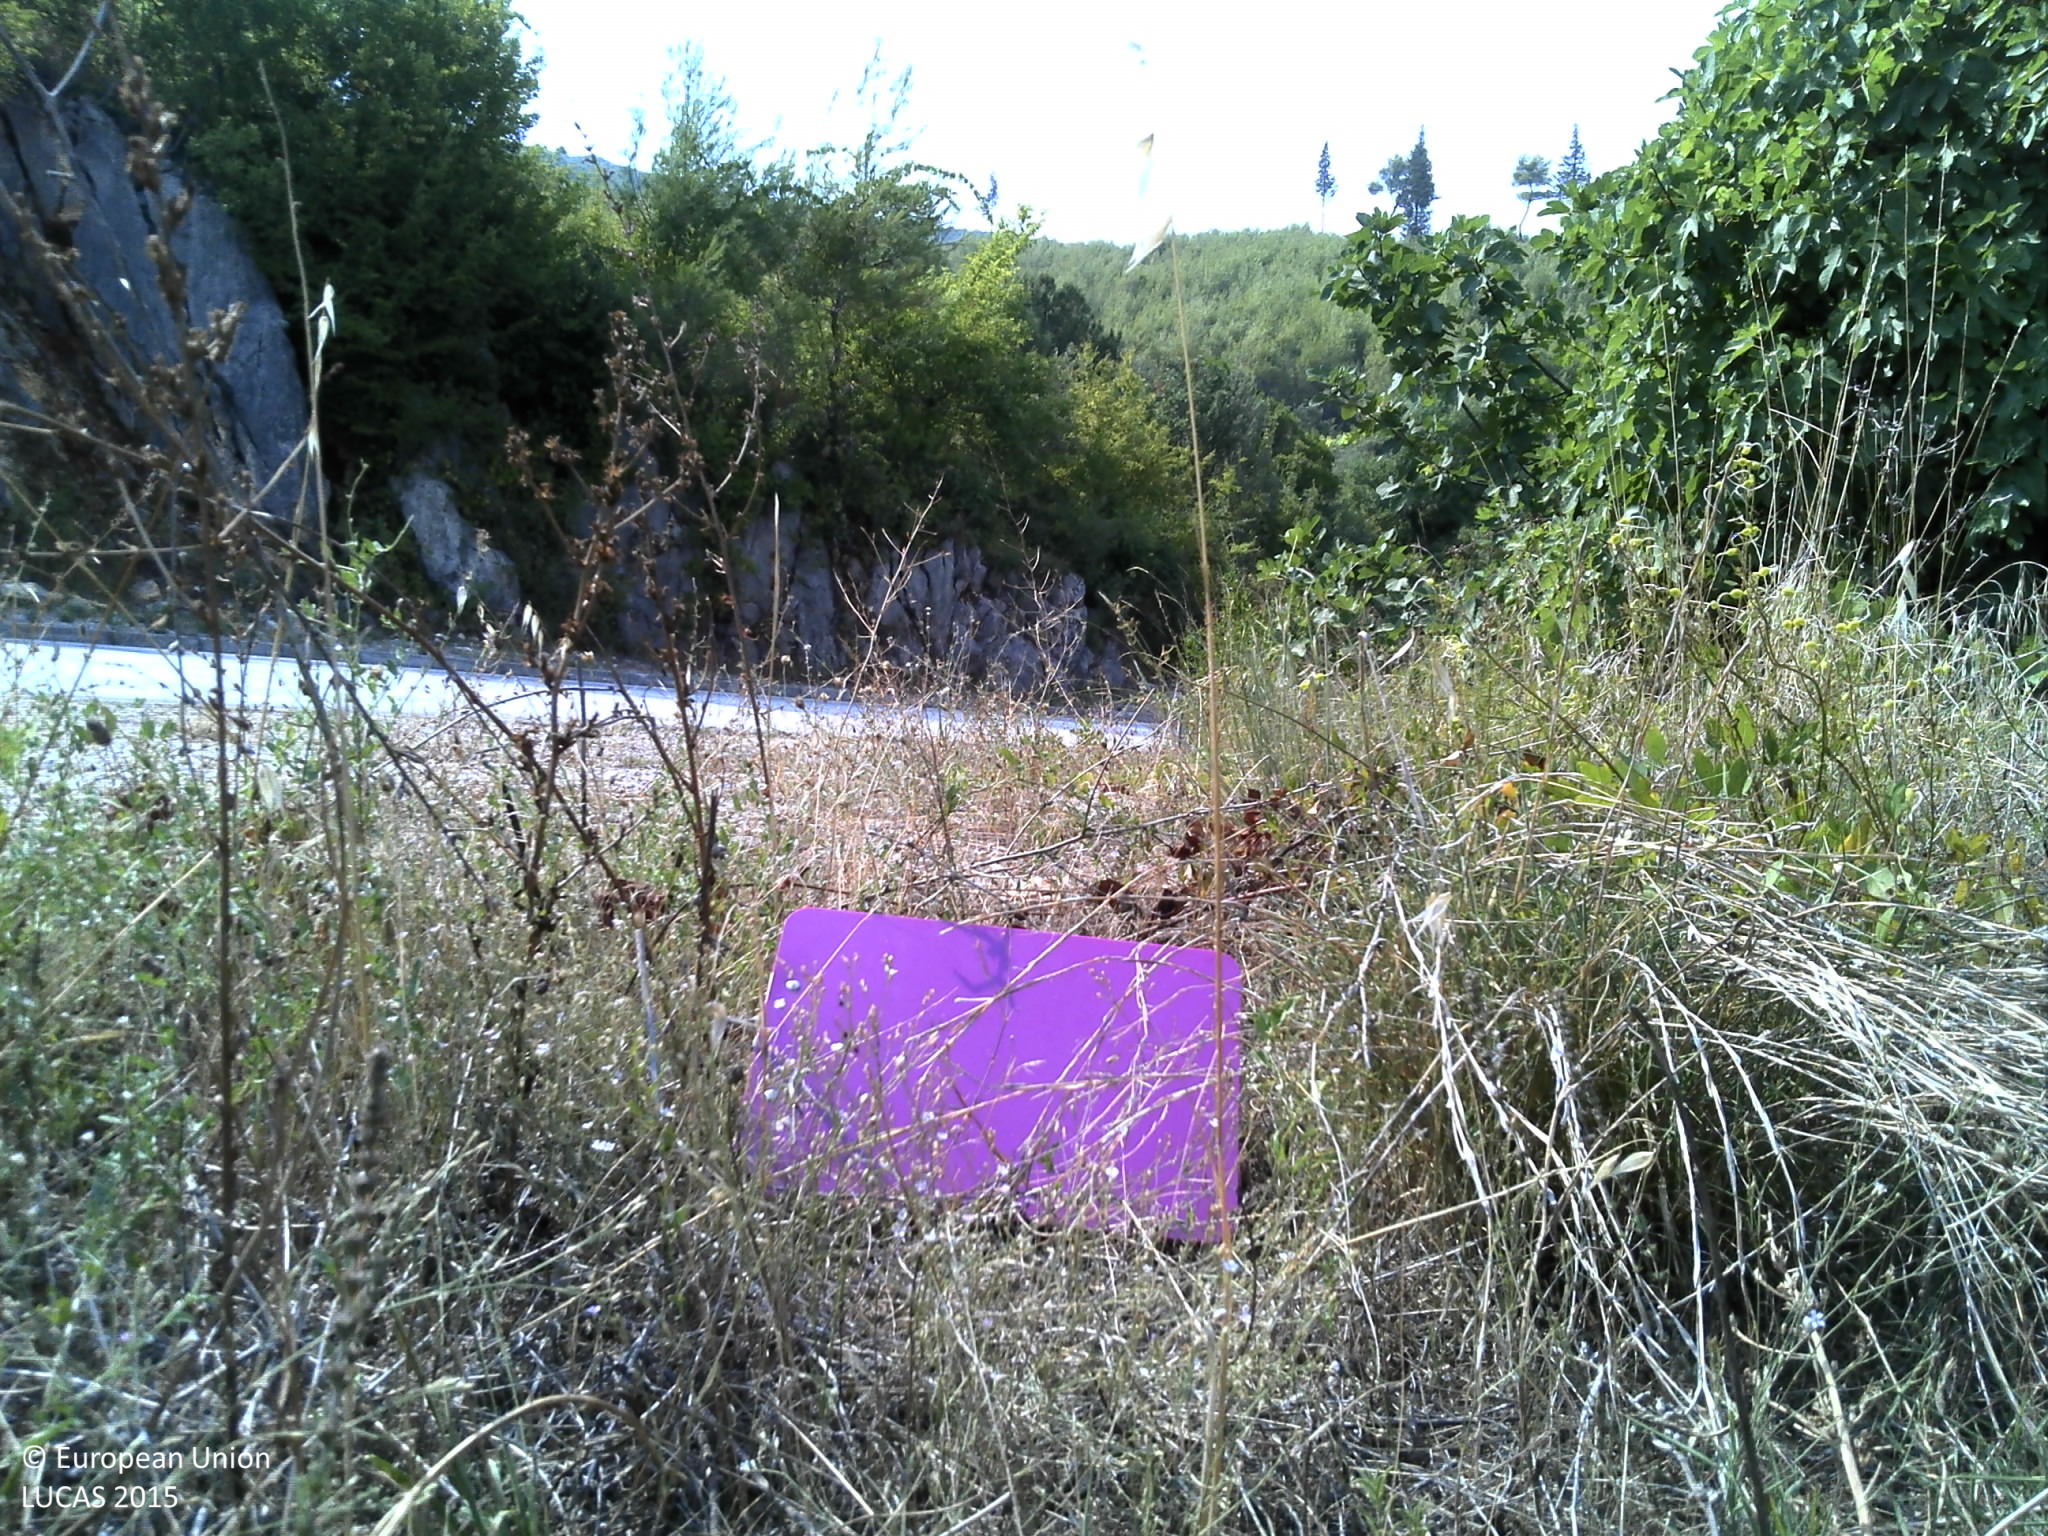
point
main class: Cropland
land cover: Other fruit trees and berries
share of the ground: 50 - 75 %
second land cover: Spontaneously vegetated surfaces
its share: > 75 %
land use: Agriculture (excluding fallow land and kitchen gardens)
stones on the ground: > 50 %
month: August
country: HR
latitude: 43.0918
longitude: 17.6202
